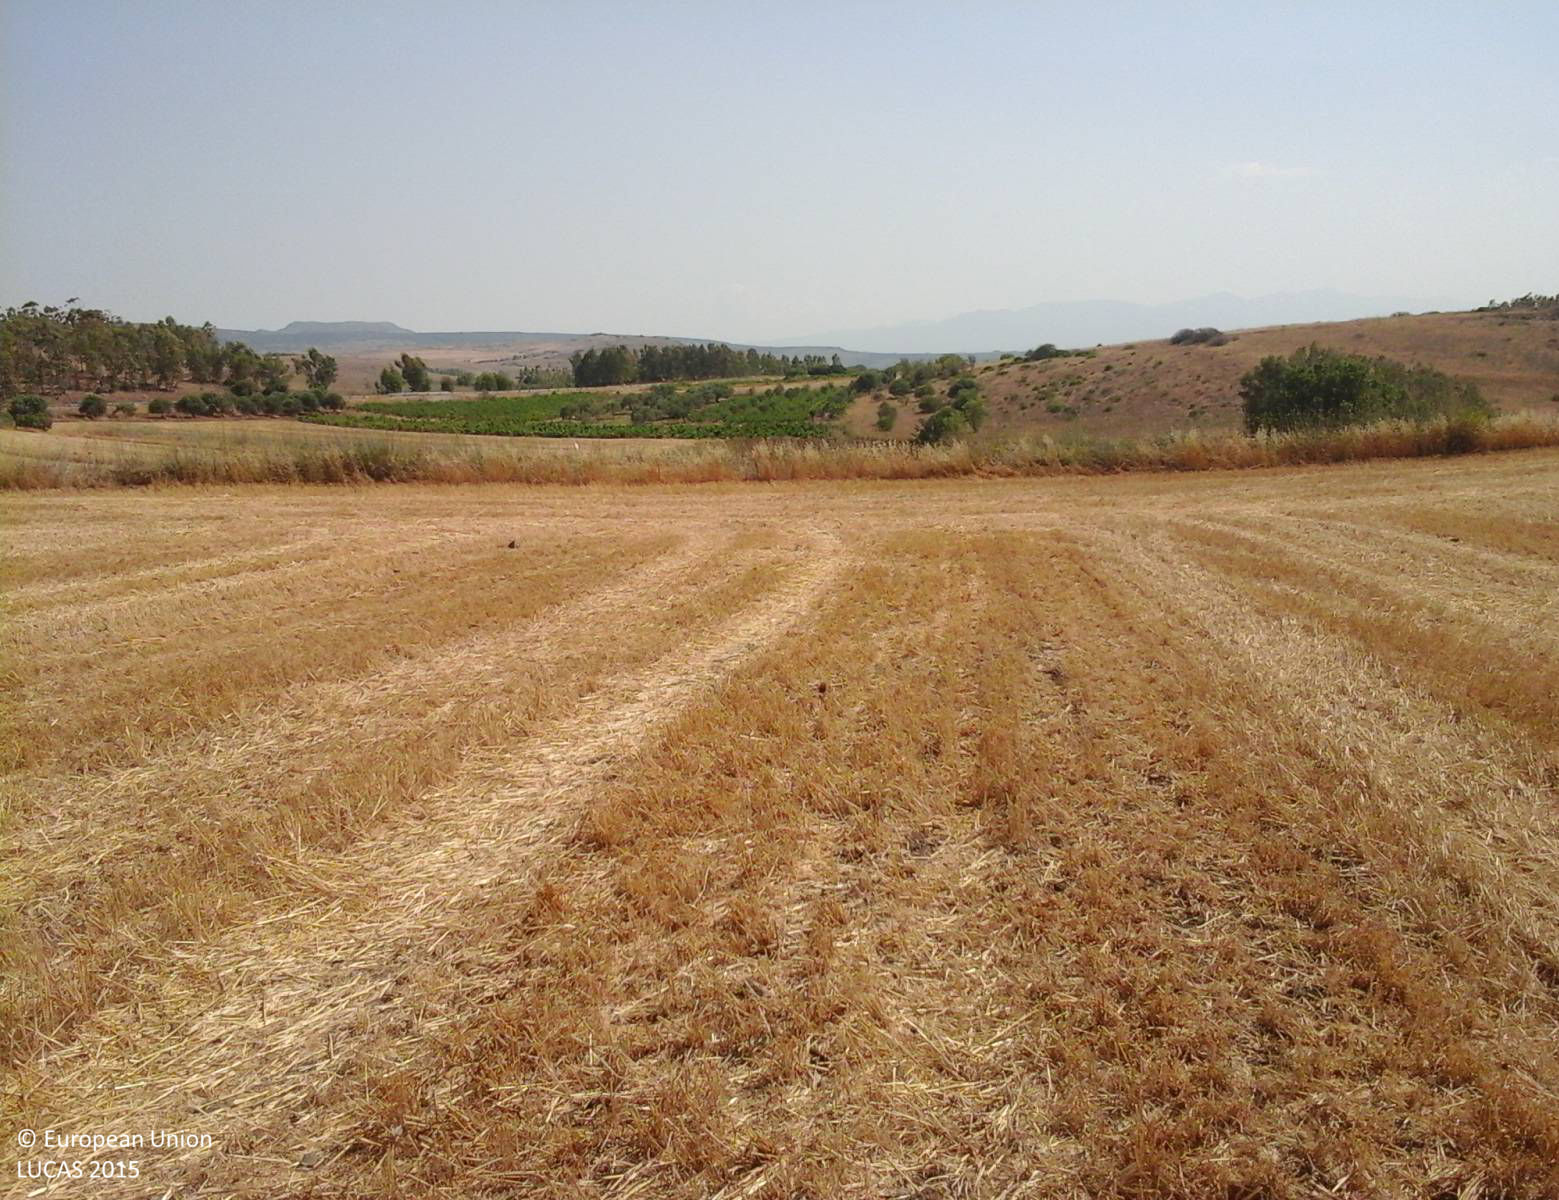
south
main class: Cropland
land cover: Barley
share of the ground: < 10 %
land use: Agriculture (excluding fallow land and kitchen gardens)
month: July
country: IT
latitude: 39.7168
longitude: 8.8053
